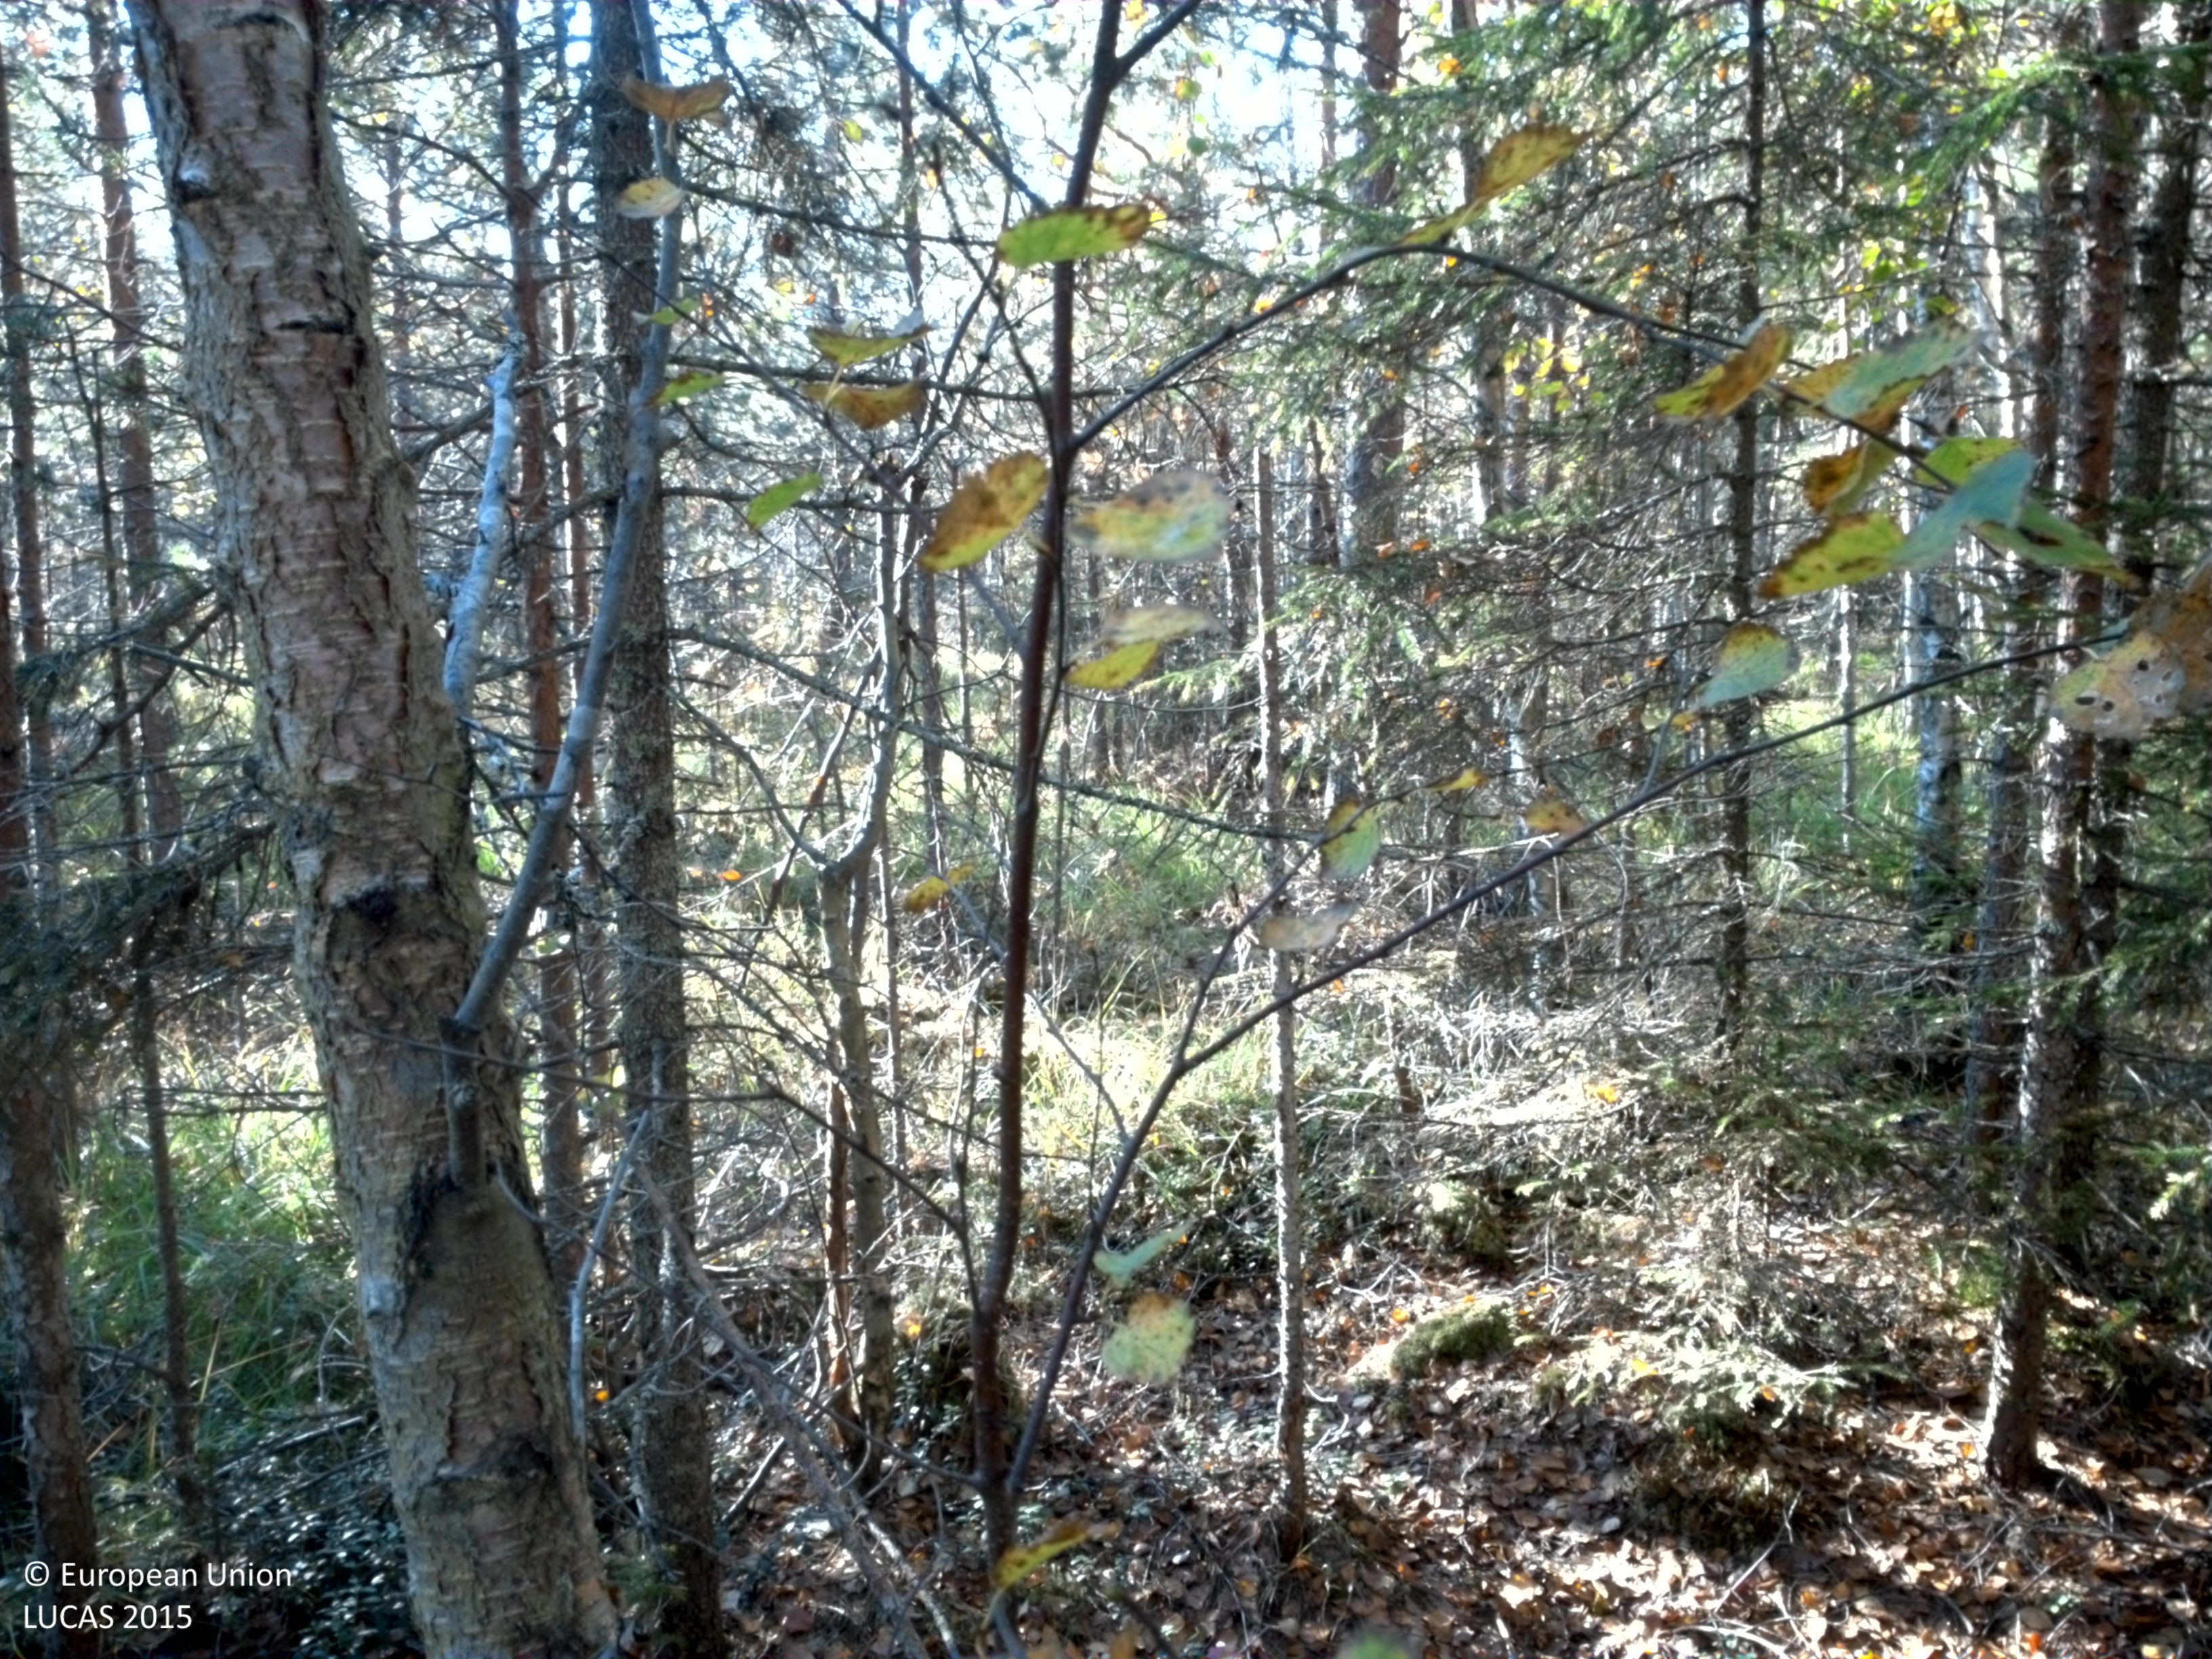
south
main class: Woodland
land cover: Pine dominated mixed woodland
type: boreal forest
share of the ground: 50 - 75 %
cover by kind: coniferous forest trees 35 %, broadleaved forest trees 30 %, shrubs 20 %, unconsolidated bare surface 10 %, lichens and mosses 5 %
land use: Forestry
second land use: Amenities, museums, leisure
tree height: < 5 m
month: September
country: SE
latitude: 65.5640
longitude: 22.3523
